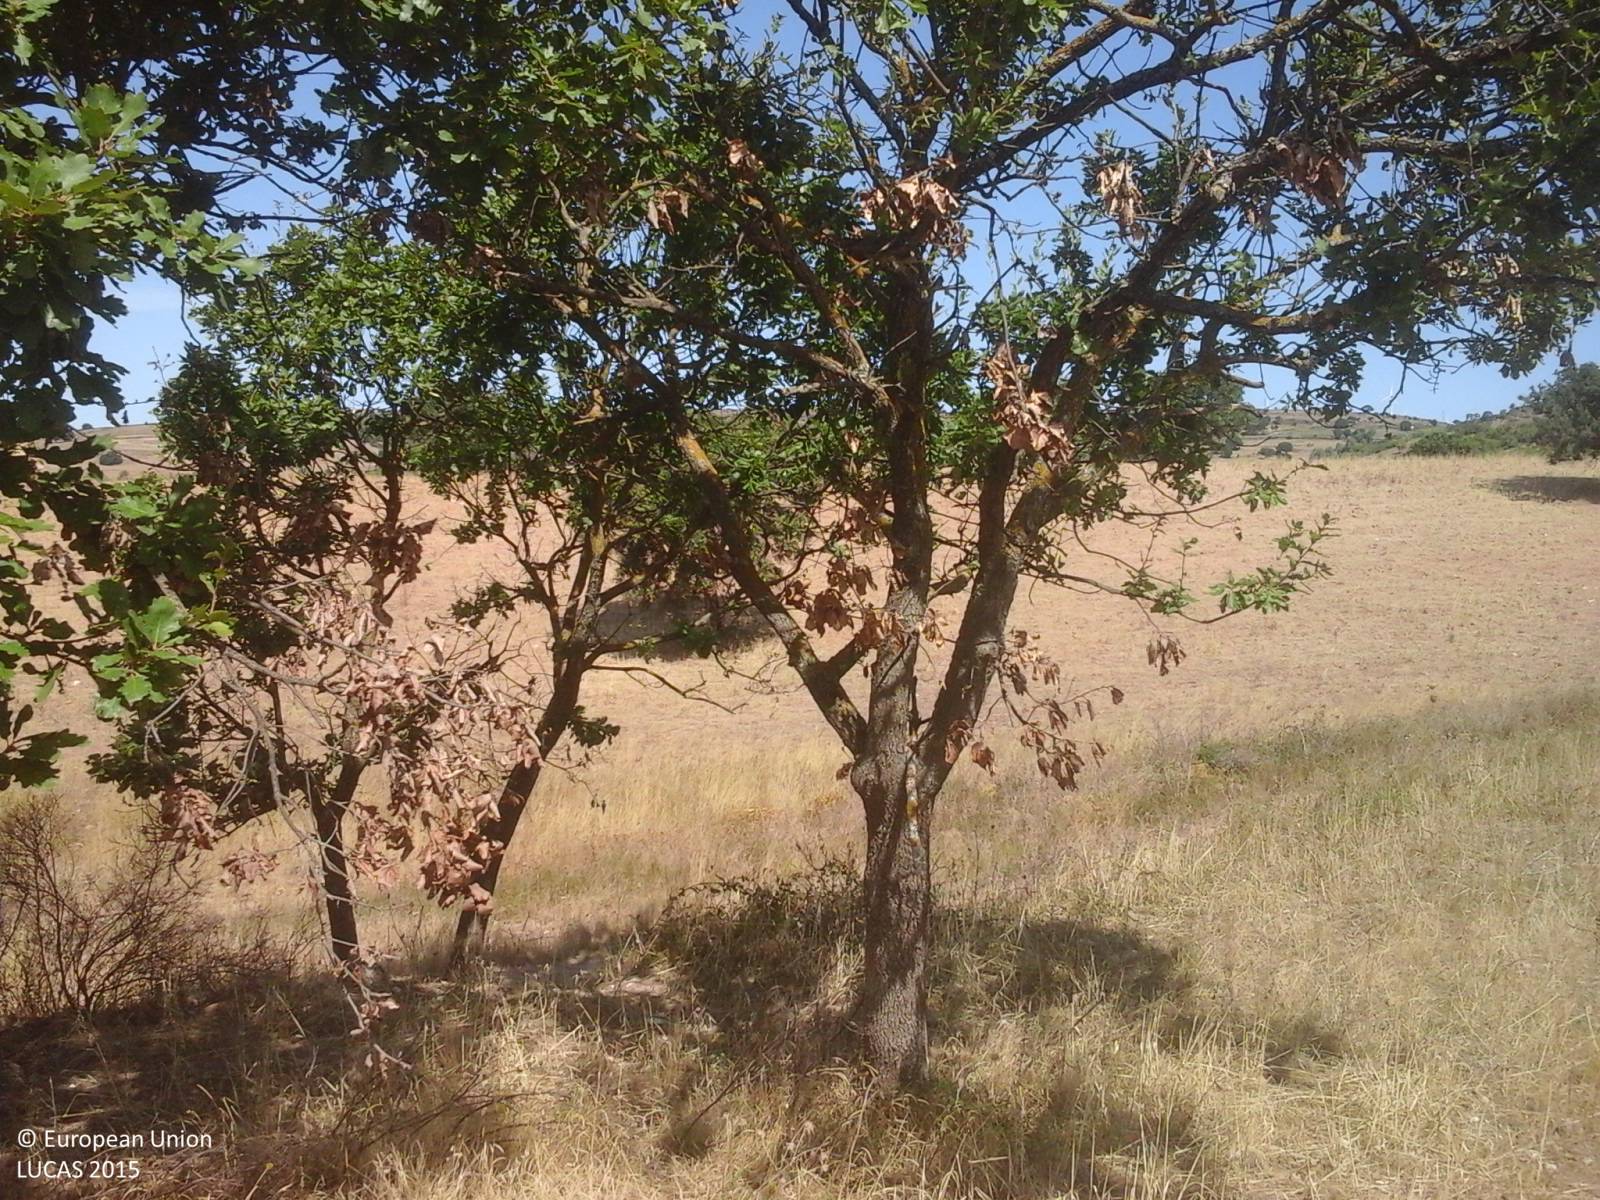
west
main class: Grassland
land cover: Grassland with sparse tree/shrub cover
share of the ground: > 75 %
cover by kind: herbaceous plants 50 %, unconsolidated bare surface 45 %, broadleaved forest trees 5 %
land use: Agriculture (excluding fallow land and kitchen gardens)
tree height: > 5 m
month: August
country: IT
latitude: 39.7027
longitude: 9.1999
